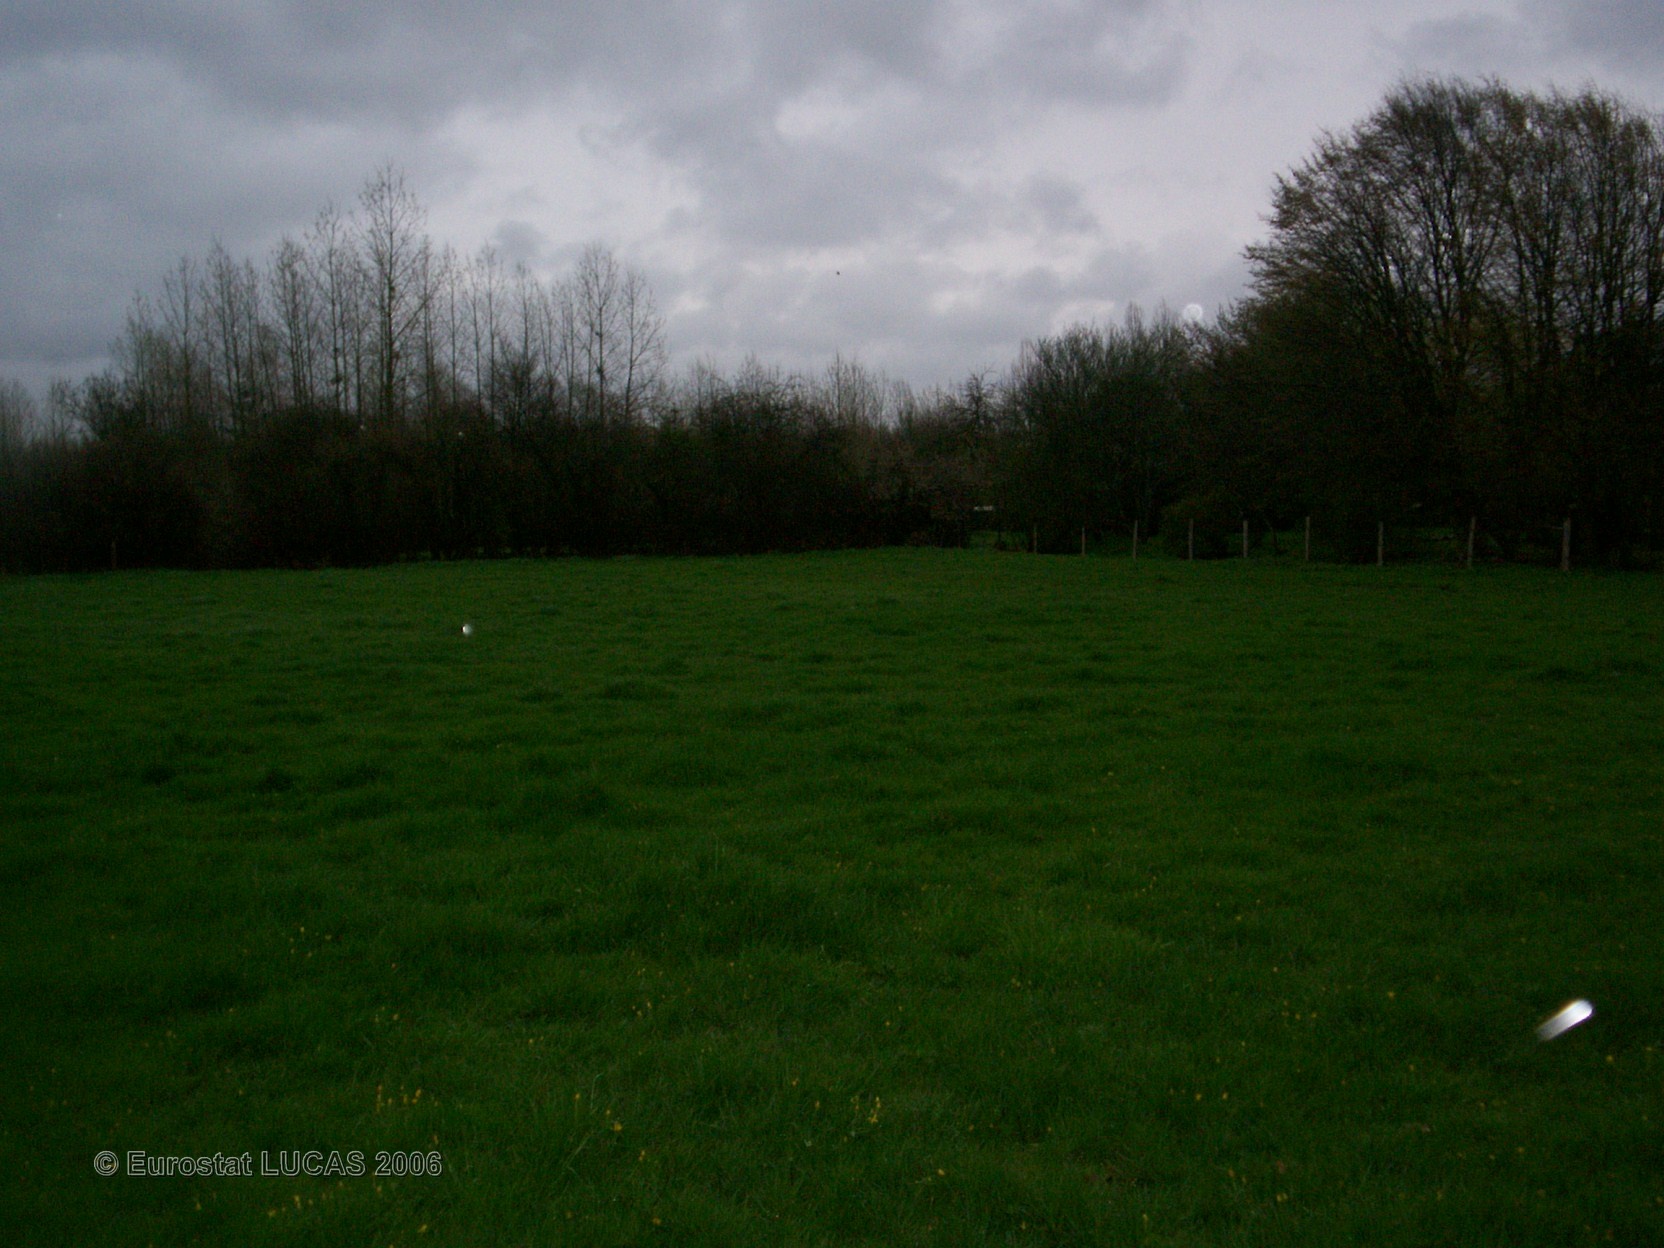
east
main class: Grassland
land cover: Grassland without tree/shrub cover
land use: Agriculture (excluding fallow land and kitchen gardens)
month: April
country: FR
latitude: 48.4656
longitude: 0.3034
